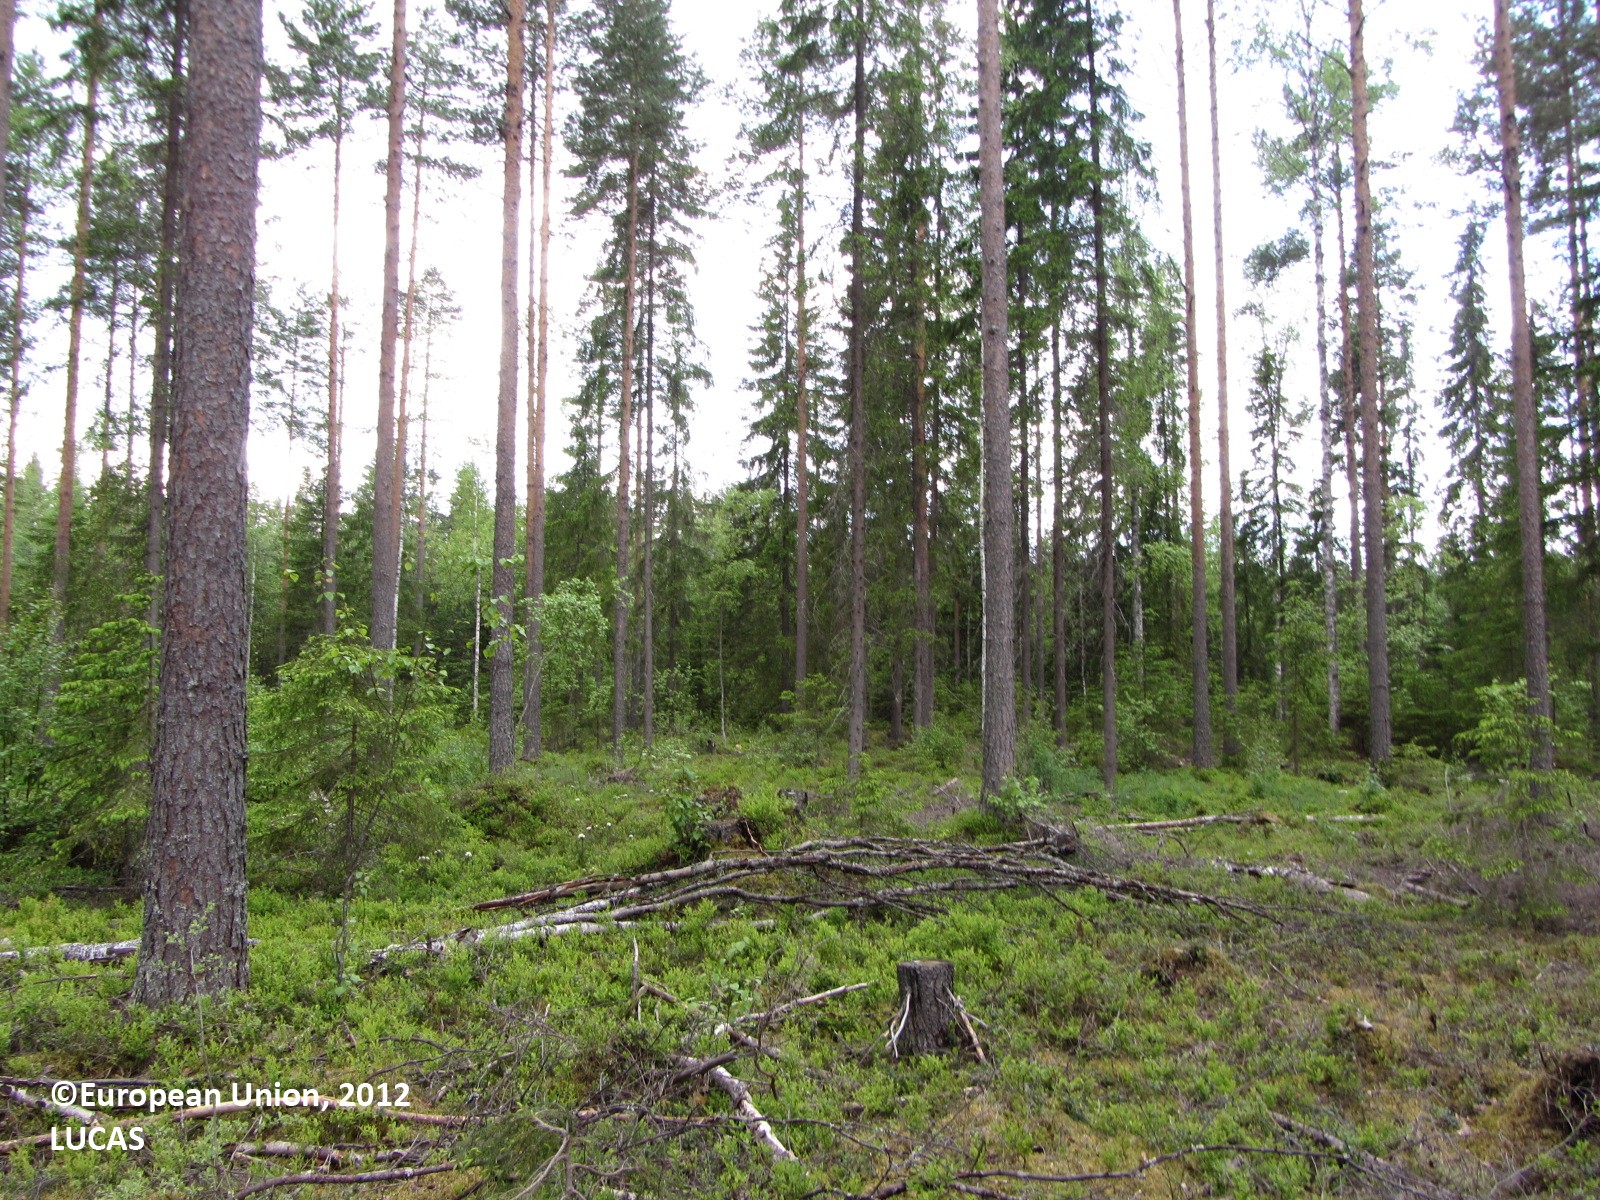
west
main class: Woodland
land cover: Pine dominated mixed woodland
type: boreal forest
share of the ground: 50 - 75 %
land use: Forestry
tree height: > 5 m
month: June
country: FI
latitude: 61.9361
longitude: 25.1033
